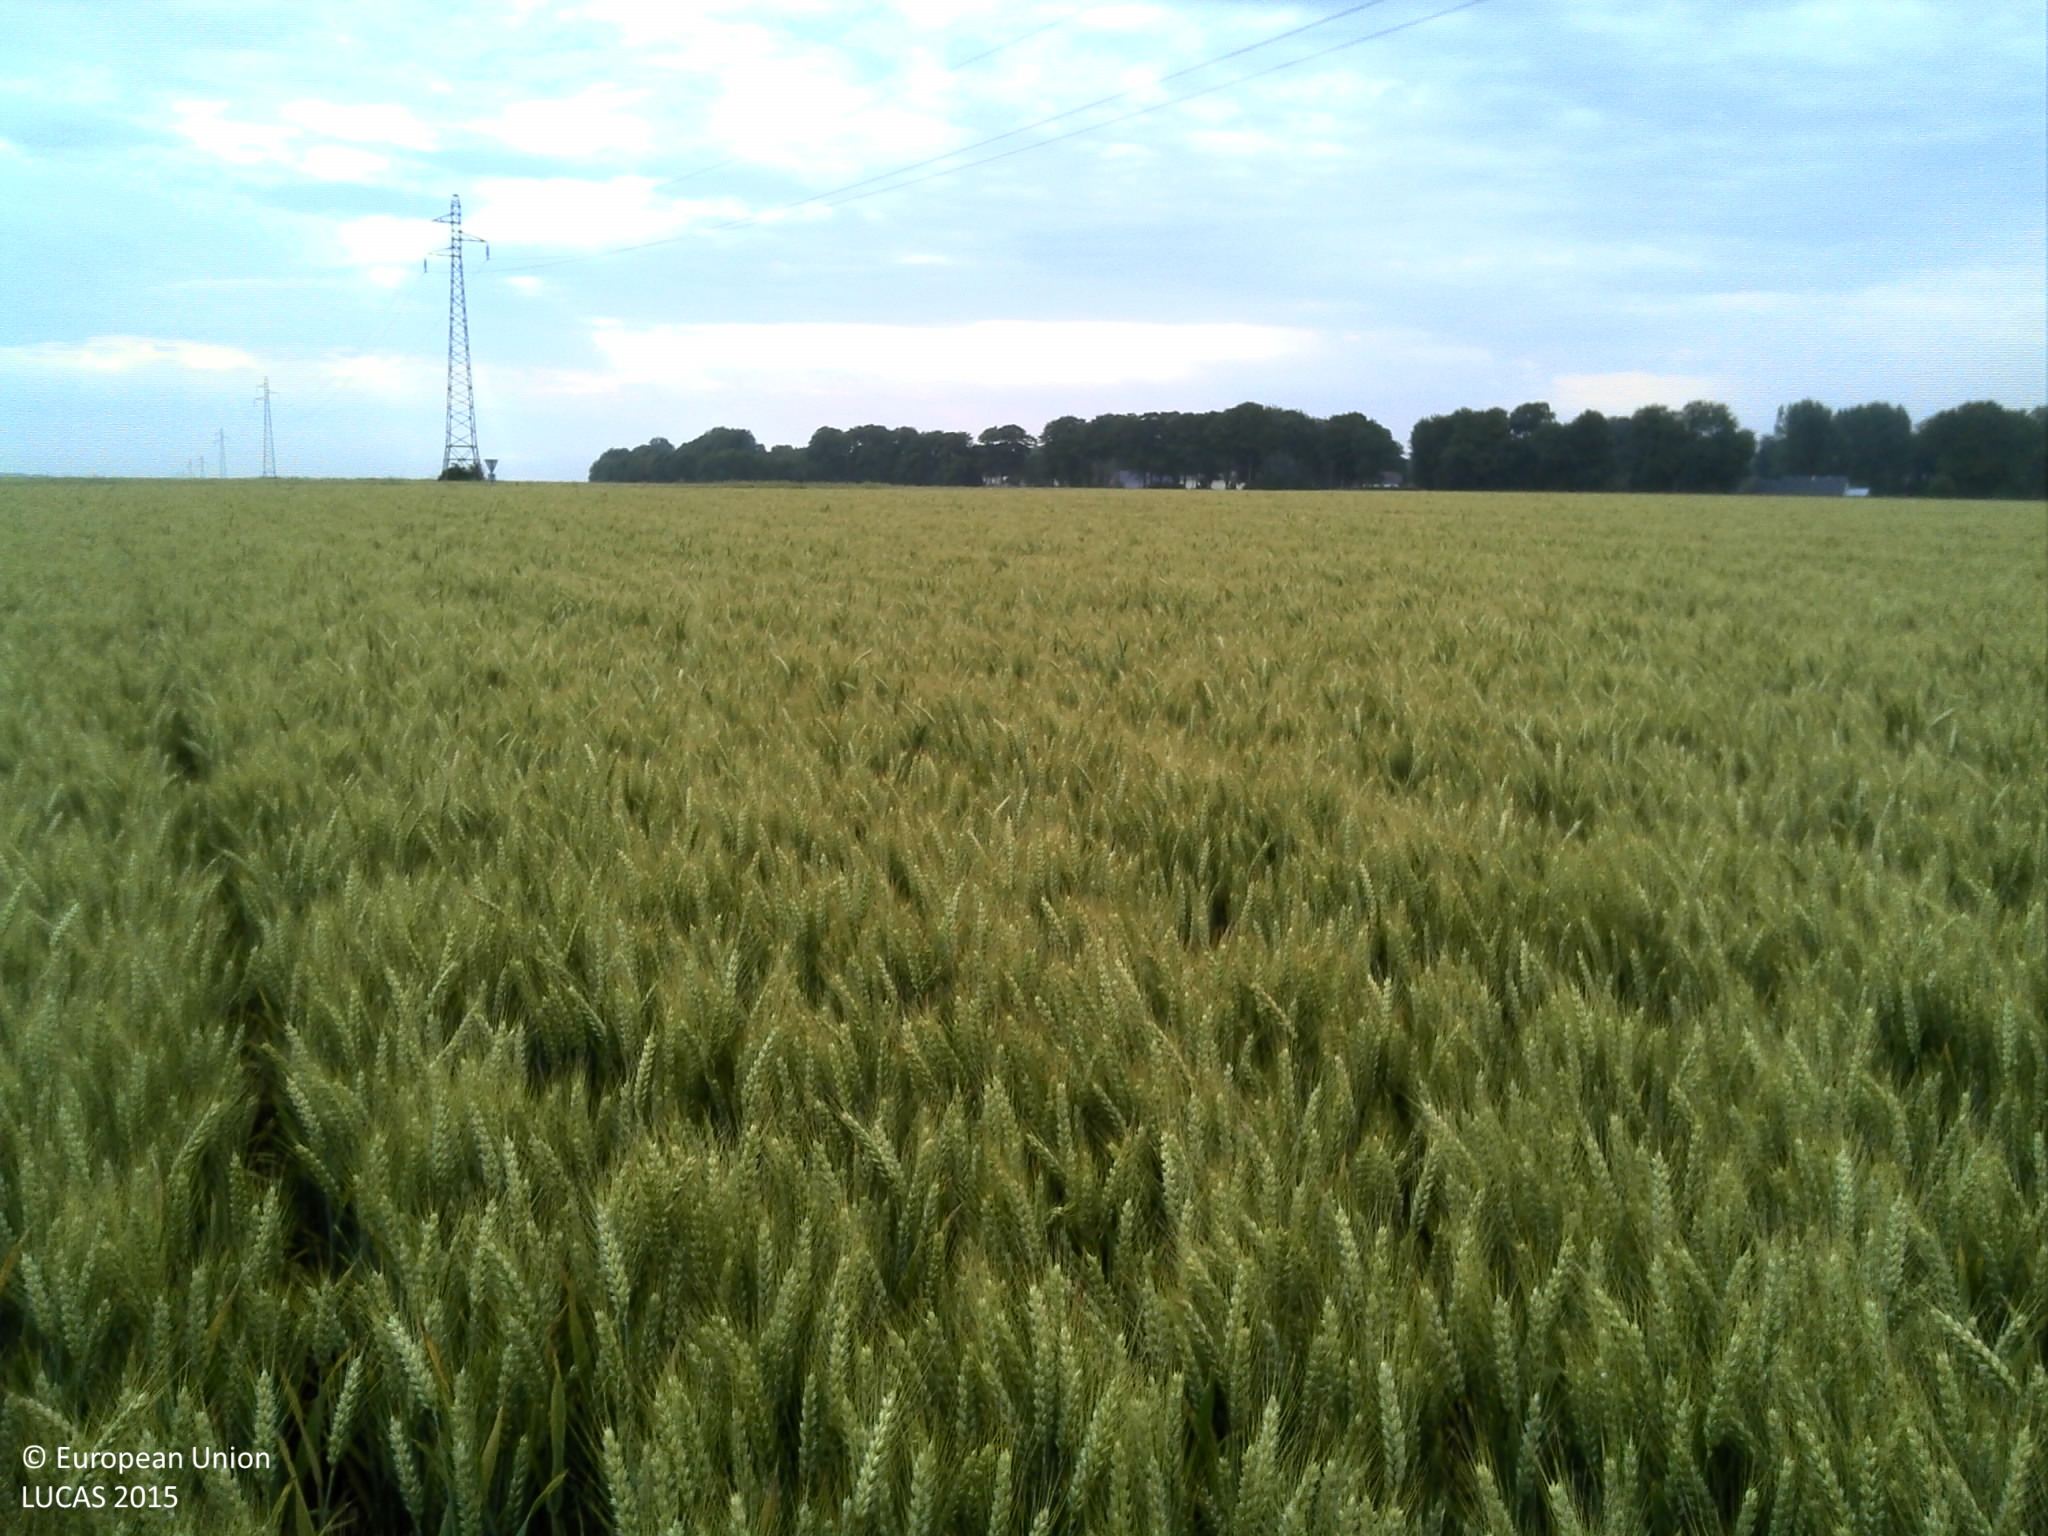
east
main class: Cropland
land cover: Durum wheat
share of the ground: > 75 %
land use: Agriculture (excluding fallow land and kitchen gardens)
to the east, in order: Durum wheat; Grass margins; Paved roads, cycling and walking lanes; Grass margins; Durum wheat; Electric lines; Durum wheat
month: July
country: FR
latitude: 49.8799
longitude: 0.9732
